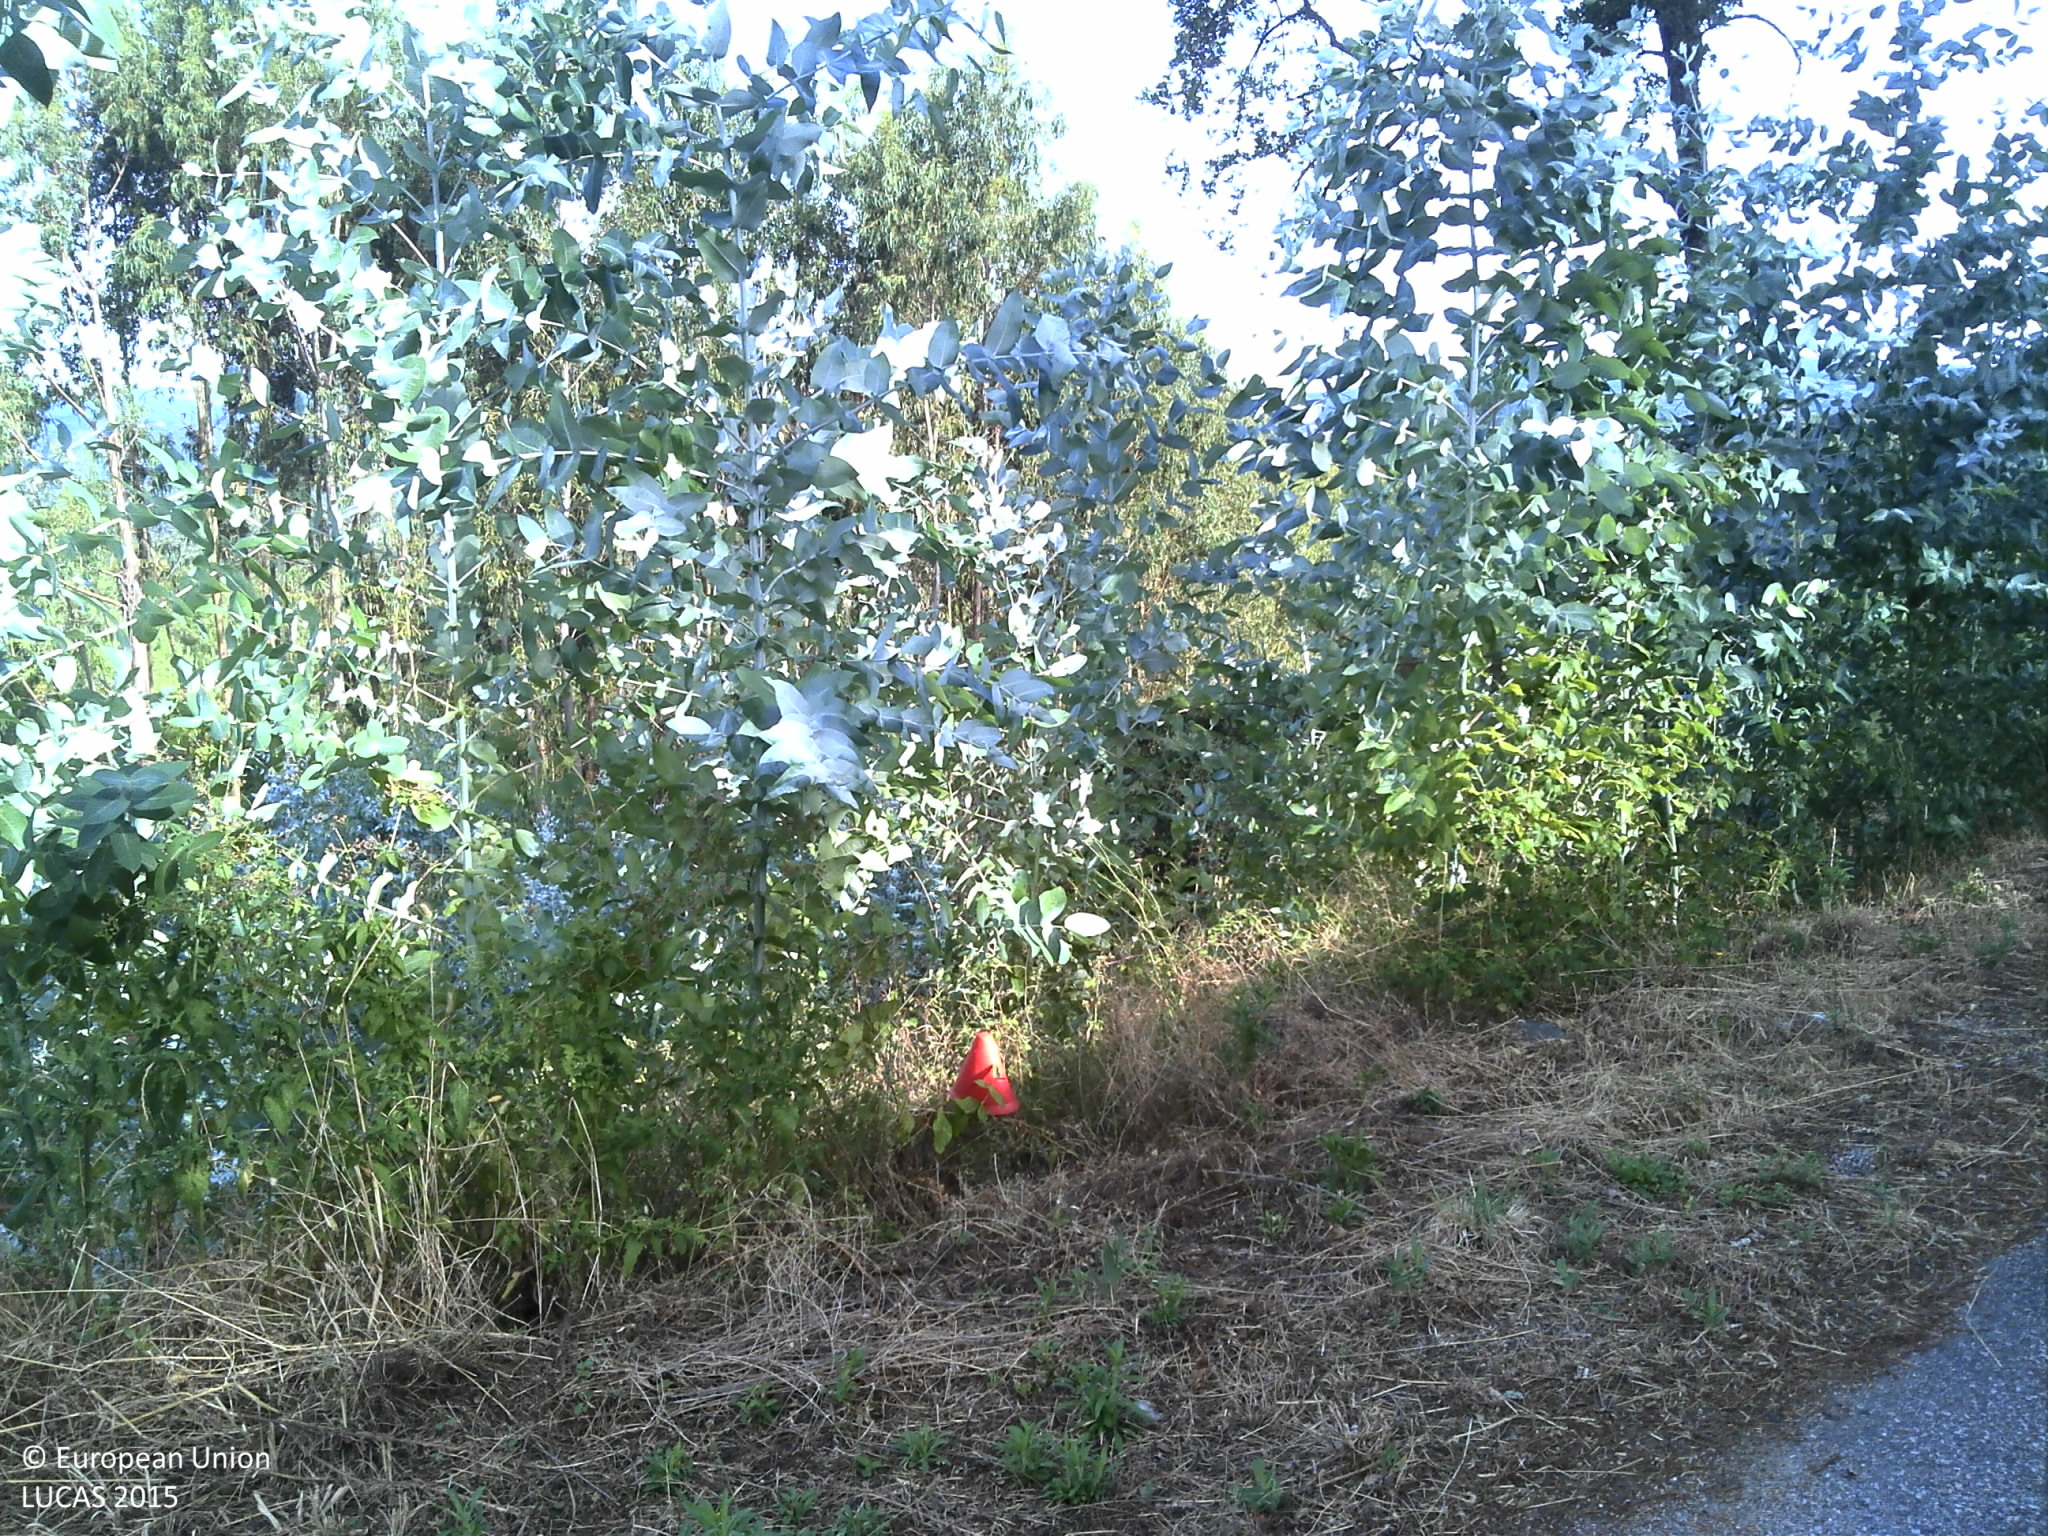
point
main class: Woodland
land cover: Broadleaved woodland
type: exotic forest
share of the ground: < 10 %
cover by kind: shrubs 90 %, broadleaved forest trees 10 %
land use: Forestry
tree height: < 5 m
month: July
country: PT
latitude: 39.8253
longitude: -7.9994
